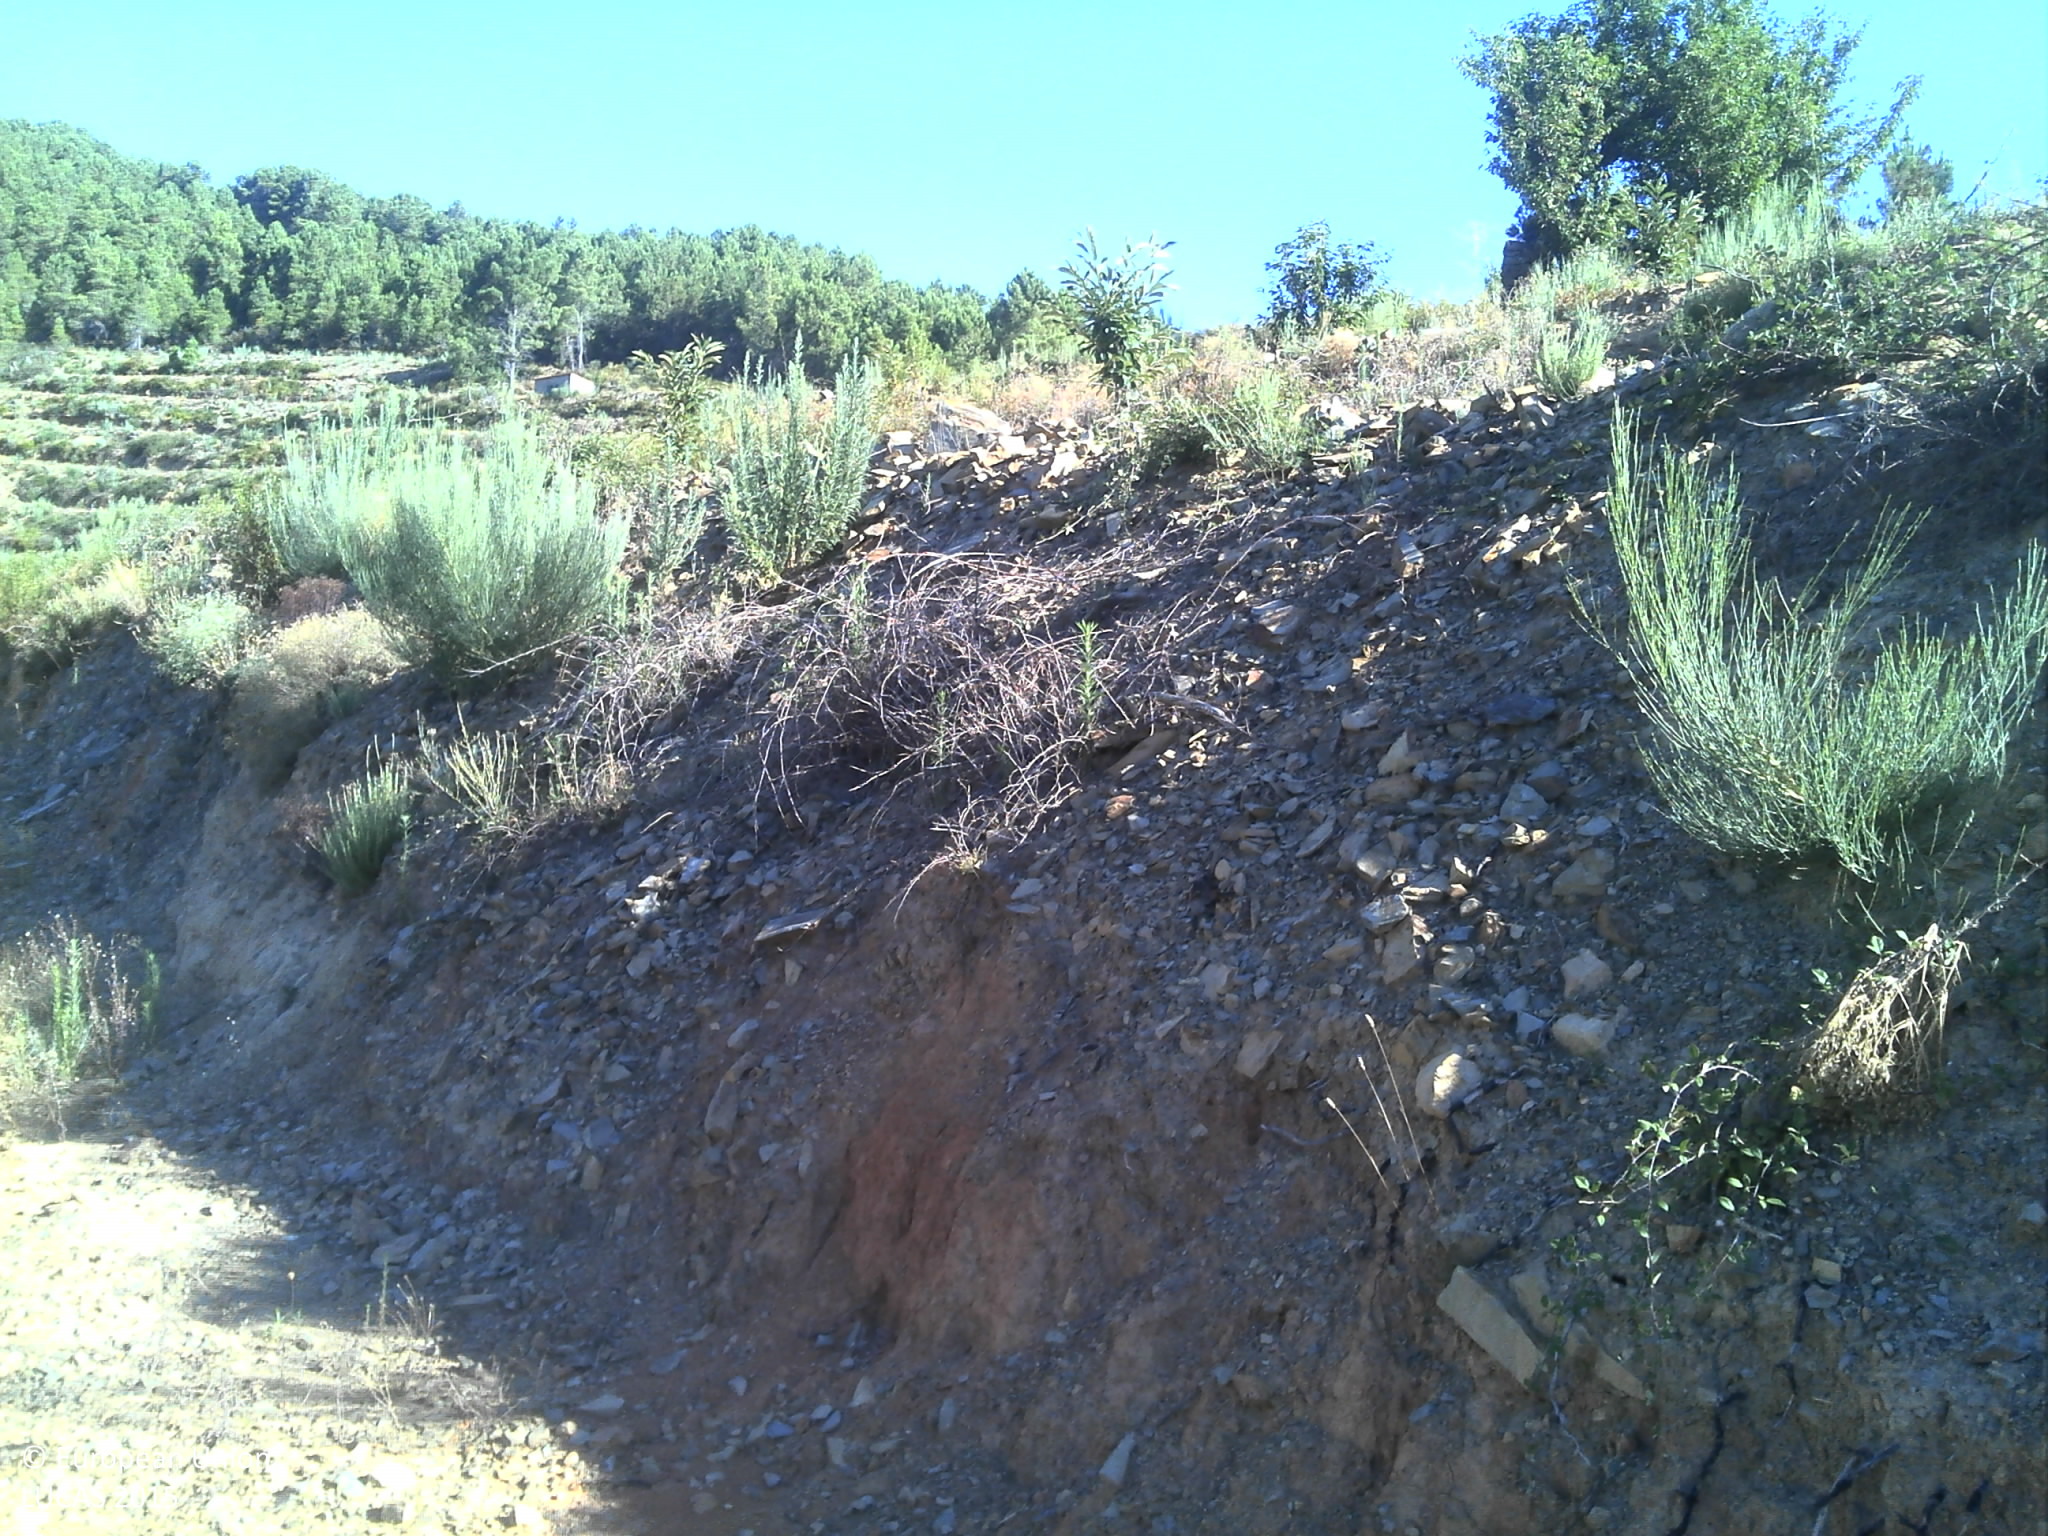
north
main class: Cropland
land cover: Nuts trees
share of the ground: < 10 %
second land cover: Other bare soil
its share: > 75 %
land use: Agriculture (excluding fallow land and kitchen gardens)
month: July
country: PT
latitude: 40.3818
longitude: -7.4827
